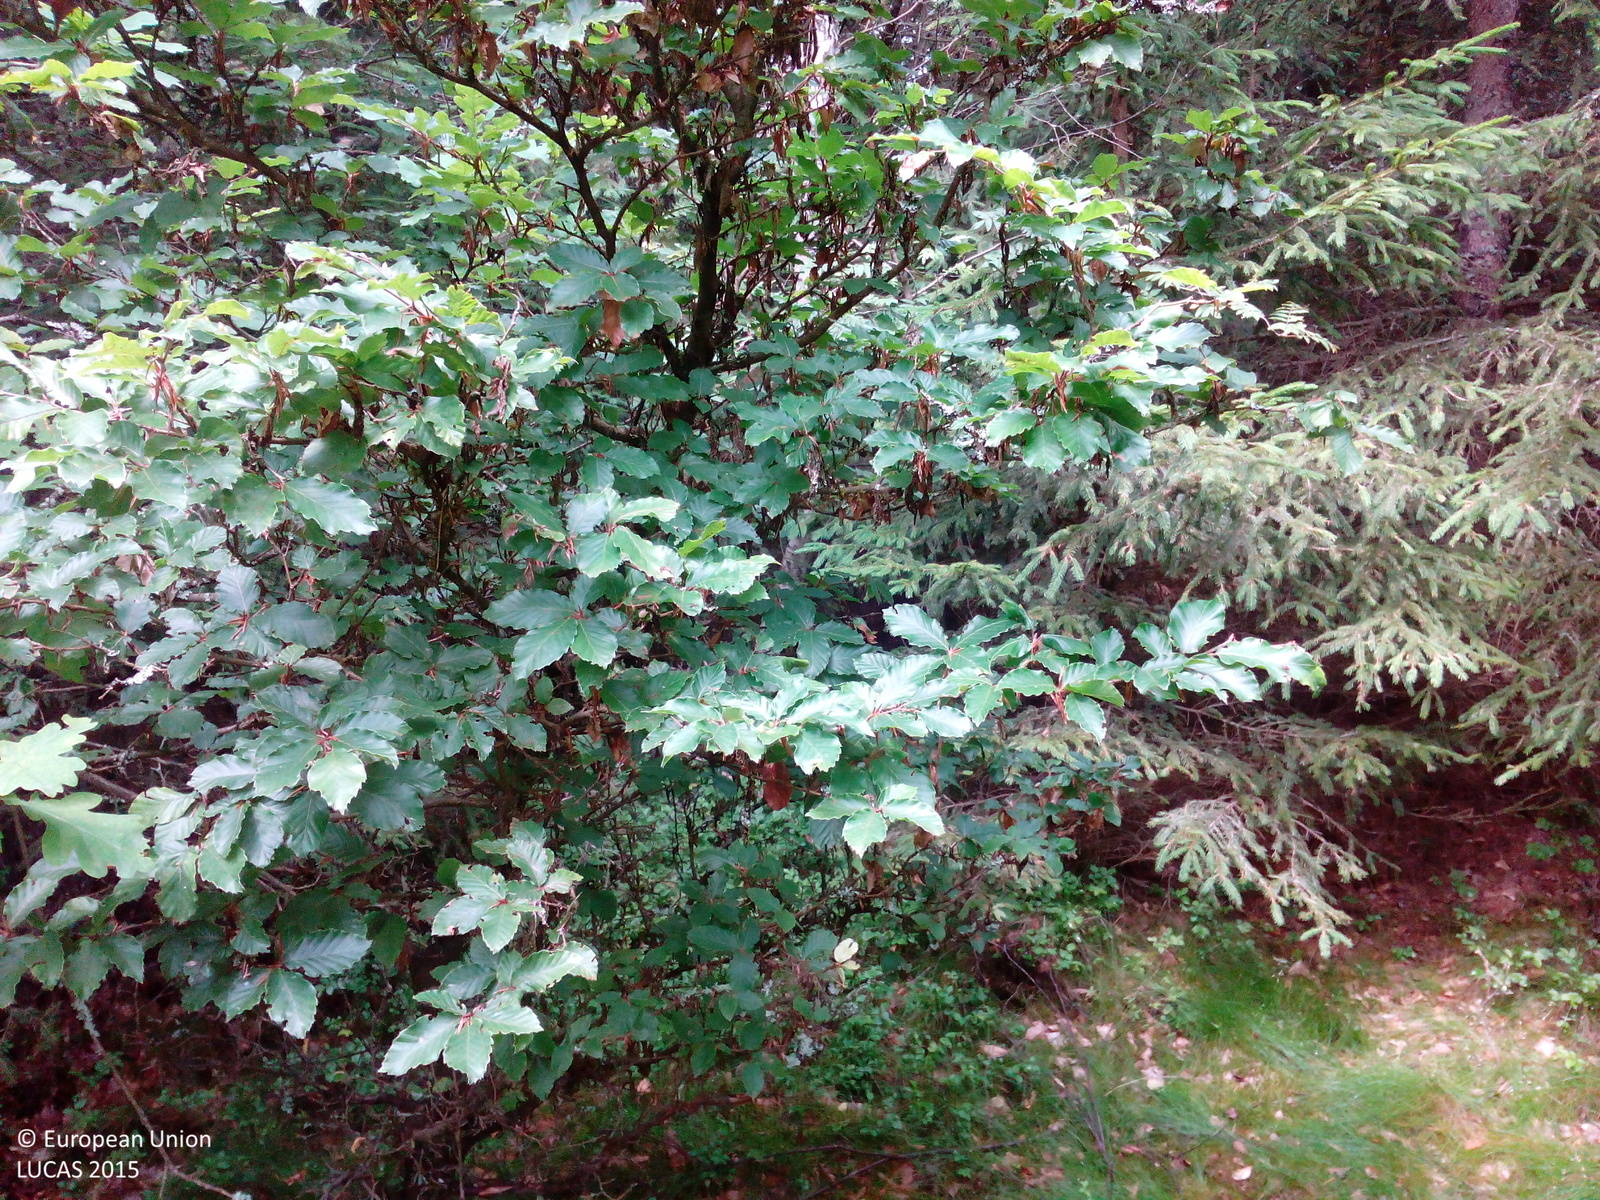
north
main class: Woodland
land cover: Spruce dominated mixed woodland
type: hemiboreal forest and nemoral coniferous forest and mixed broadleaved-coniferous forest
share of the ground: > 75 %
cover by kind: coniferous forest trees 60 %, broadleaved forest trees 25 %, herbaceous plants 15 %
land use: Forestry
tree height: < 5 m
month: July
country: DE
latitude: 49.7098
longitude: 12.3709
